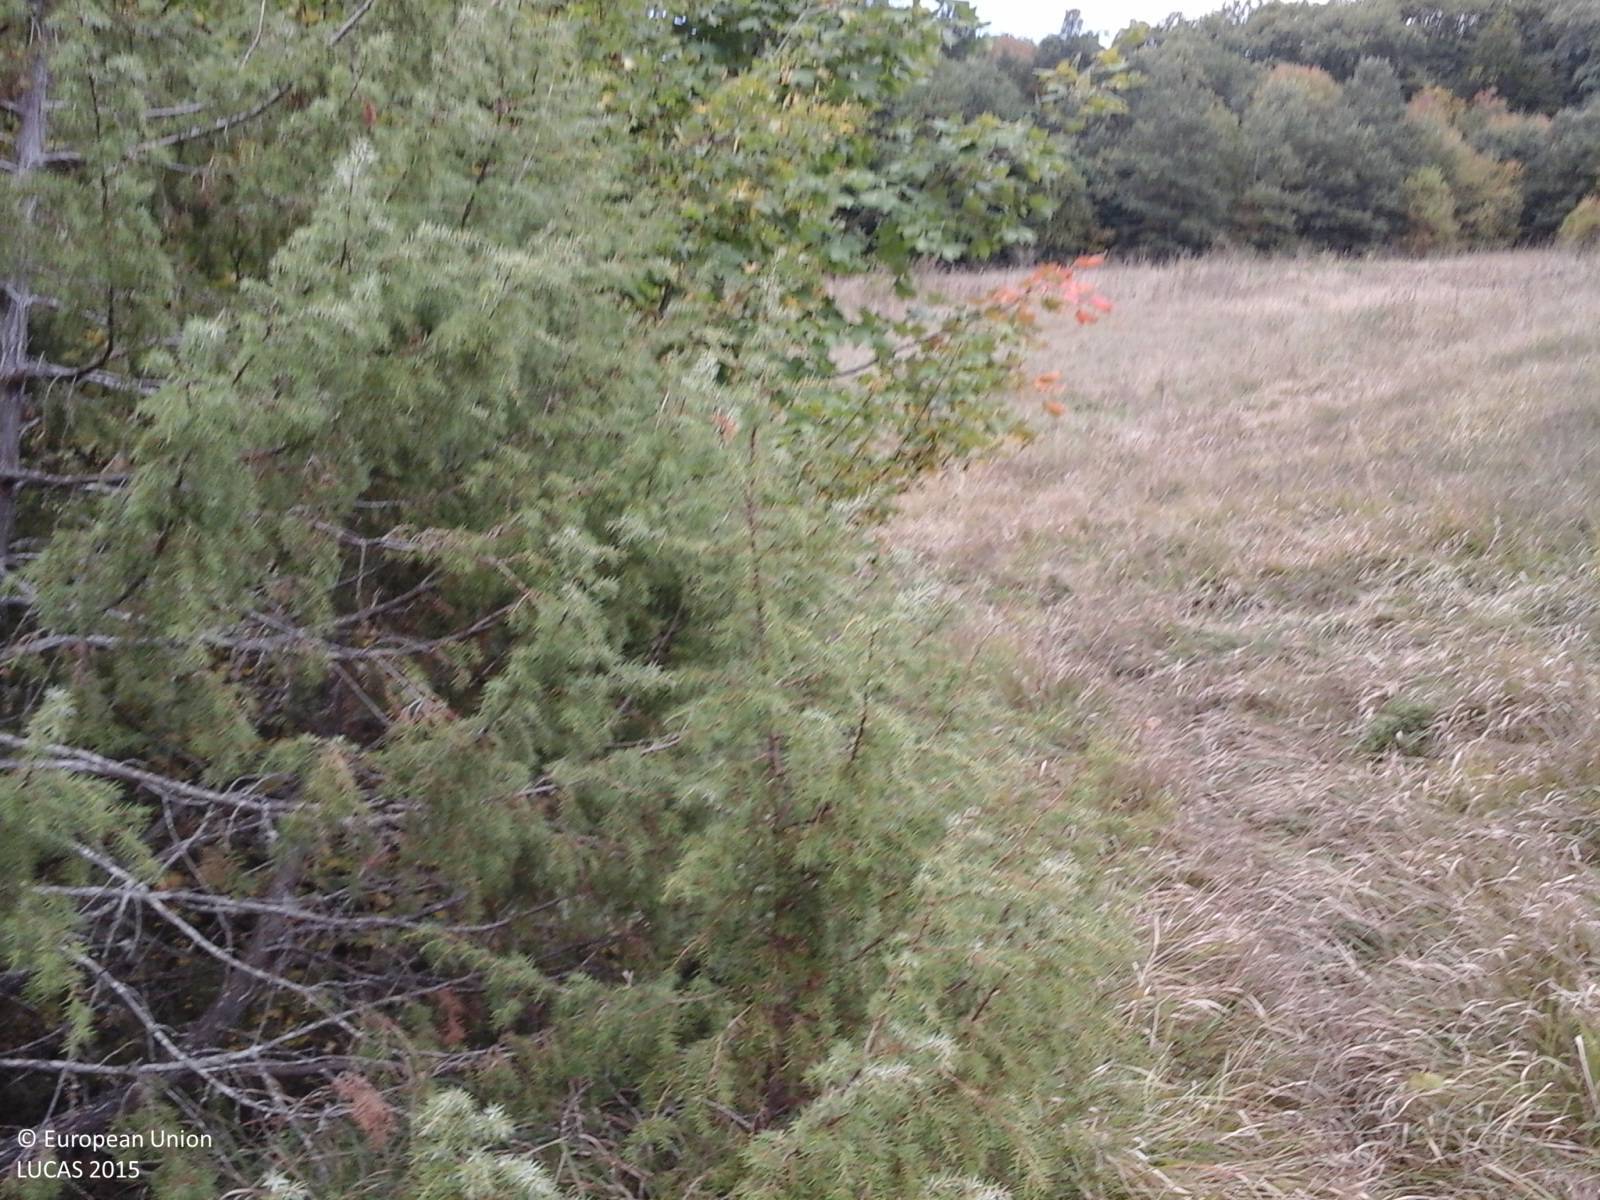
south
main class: Shrubland
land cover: Shrubland with sparse tree cover
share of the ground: > 75 %
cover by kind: shrubs 80 %, herbaceous plants 15 %, broadleaved forest trees 5 %
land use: Semi-natural and natural areas not in use
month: October
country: IT
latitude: 42.5502
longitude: 13.1686
